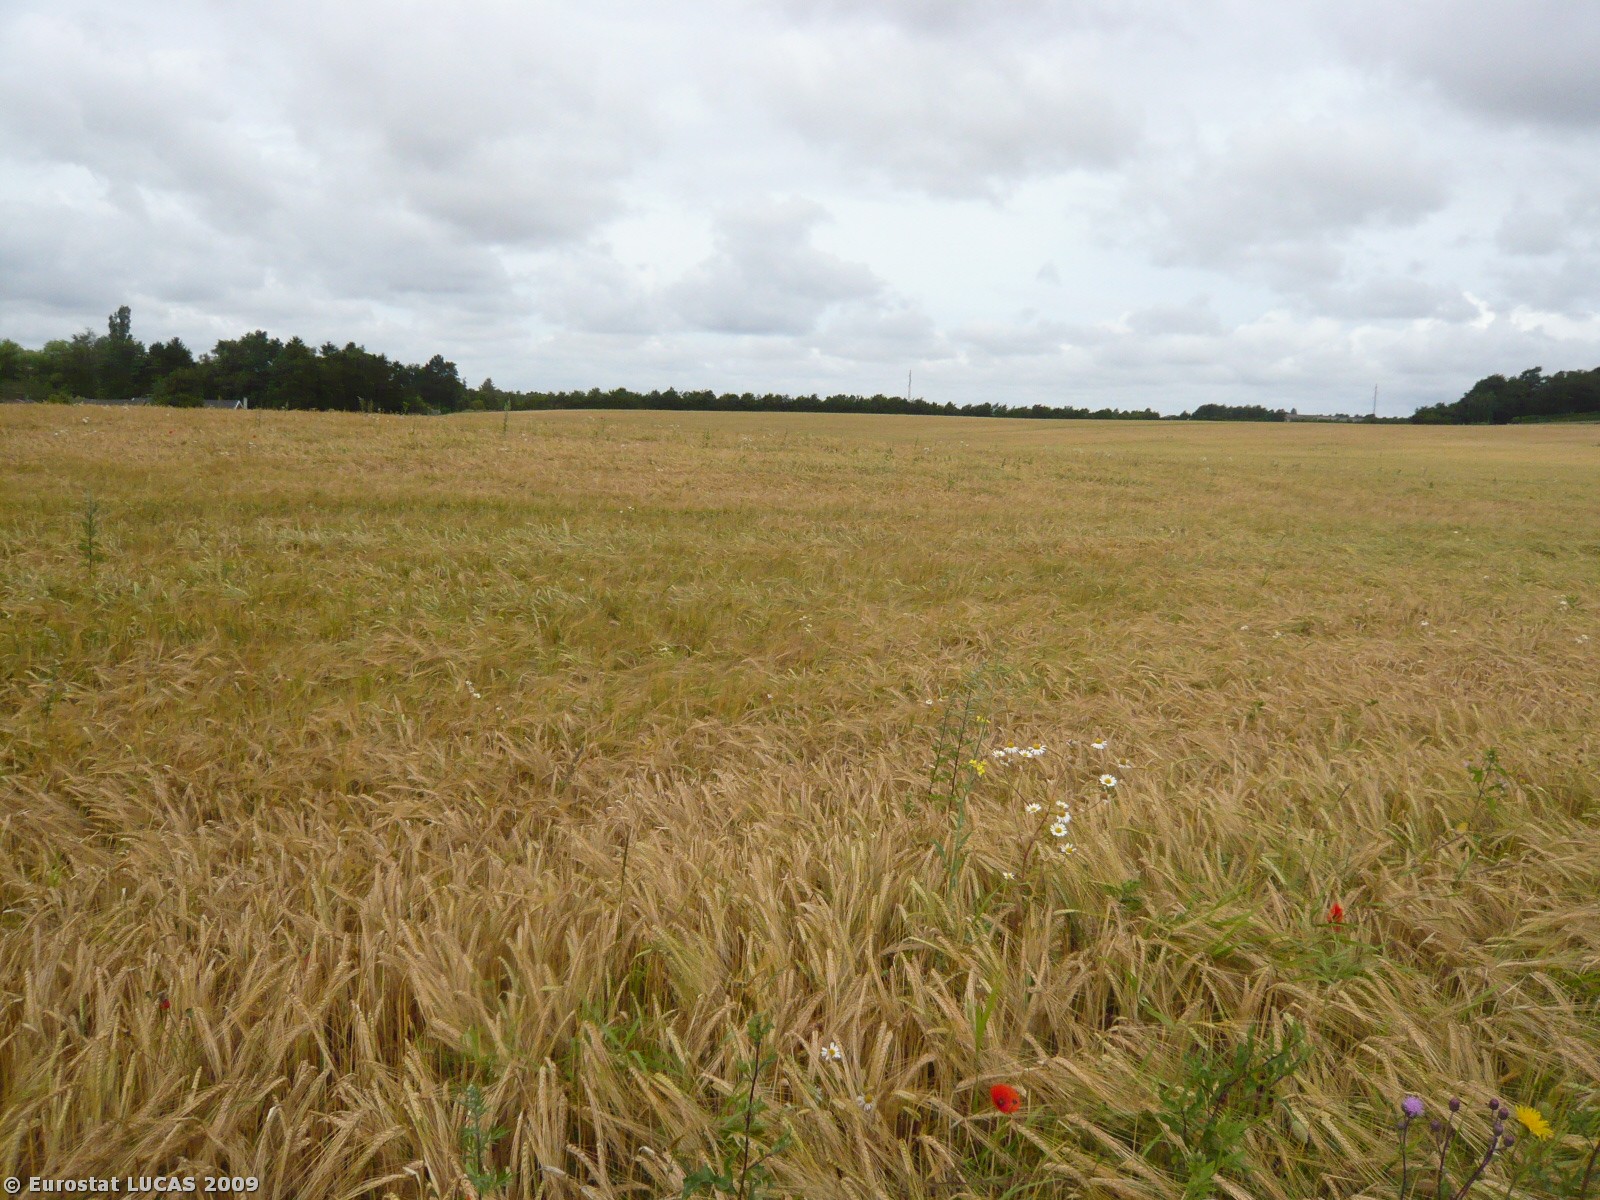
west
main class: Cropland
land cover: Barley
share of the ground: > 75 %
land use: Agriculture (excluding fallow land and kitchen gardens)
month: July
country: DK
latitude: 55.6838
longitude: 12.1771
